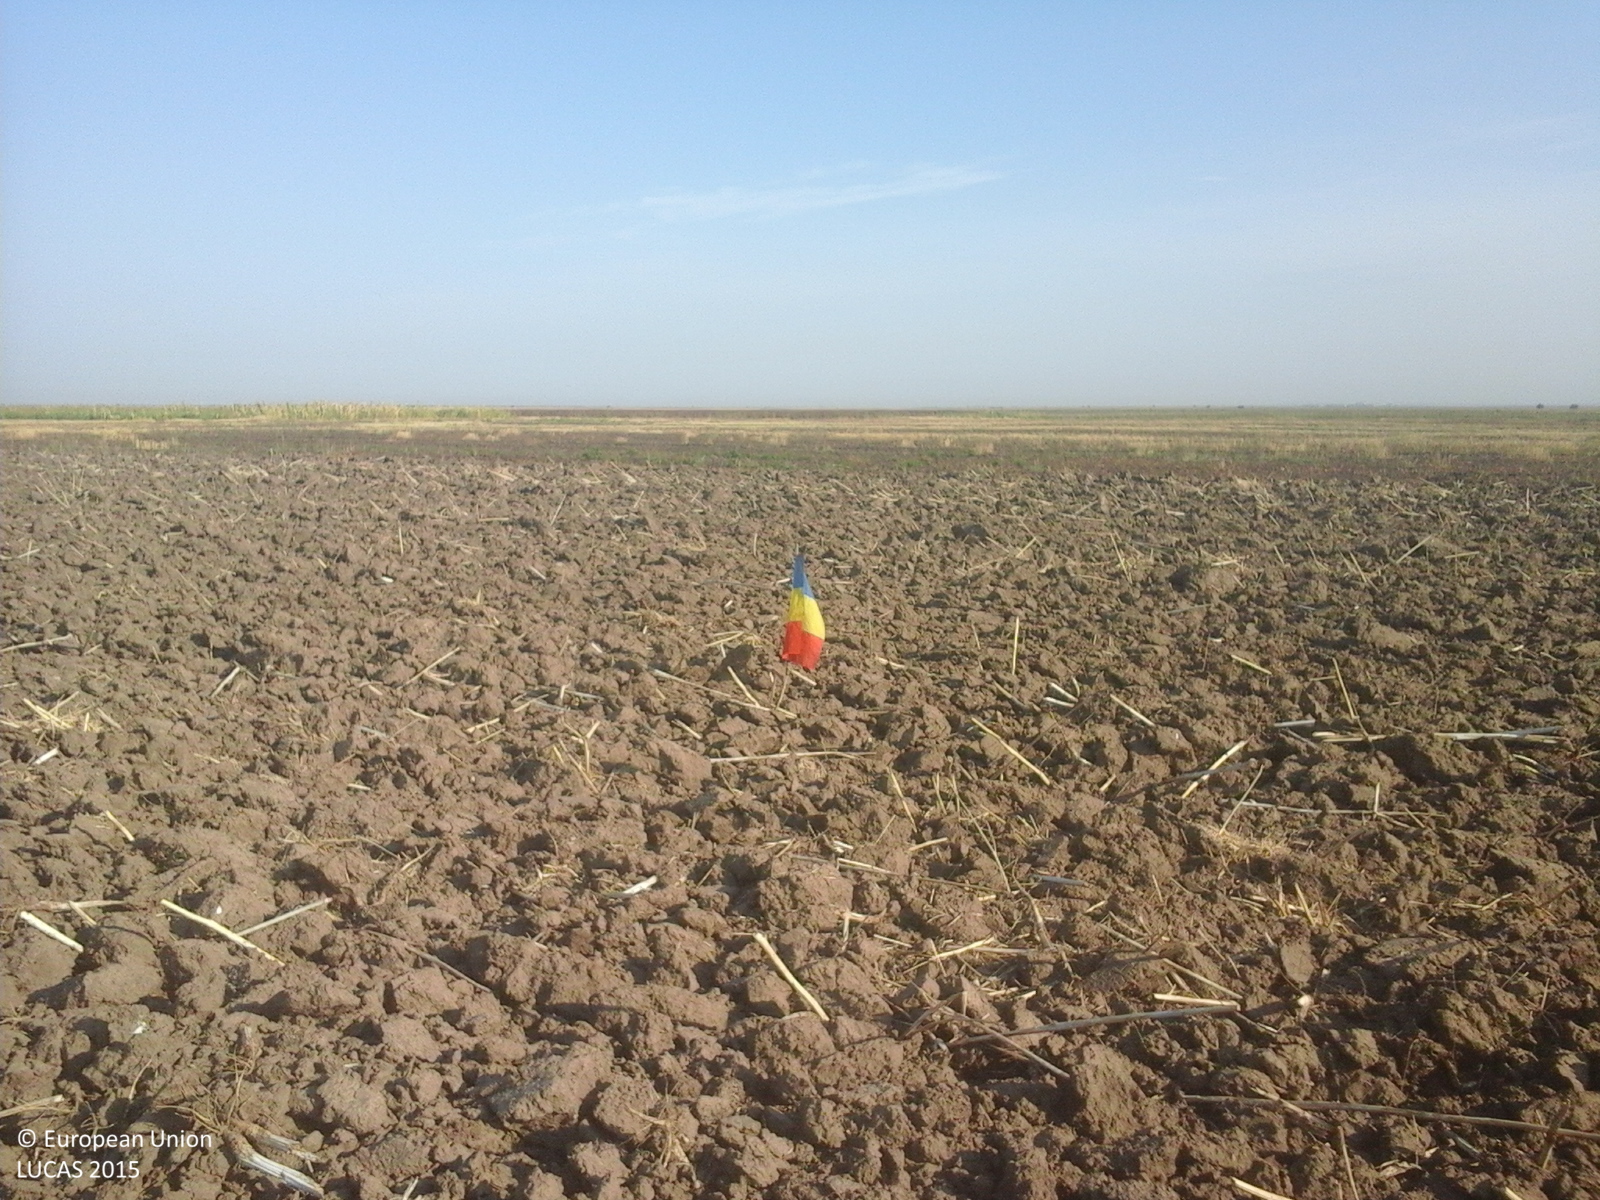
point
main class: Cropland
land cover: Rape and turnip rape
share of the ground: < 10 %
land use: Agriculture (excluding fallow land and kitchen gardens)
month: August
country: RO
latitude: 44.1661
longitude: 23.0115
